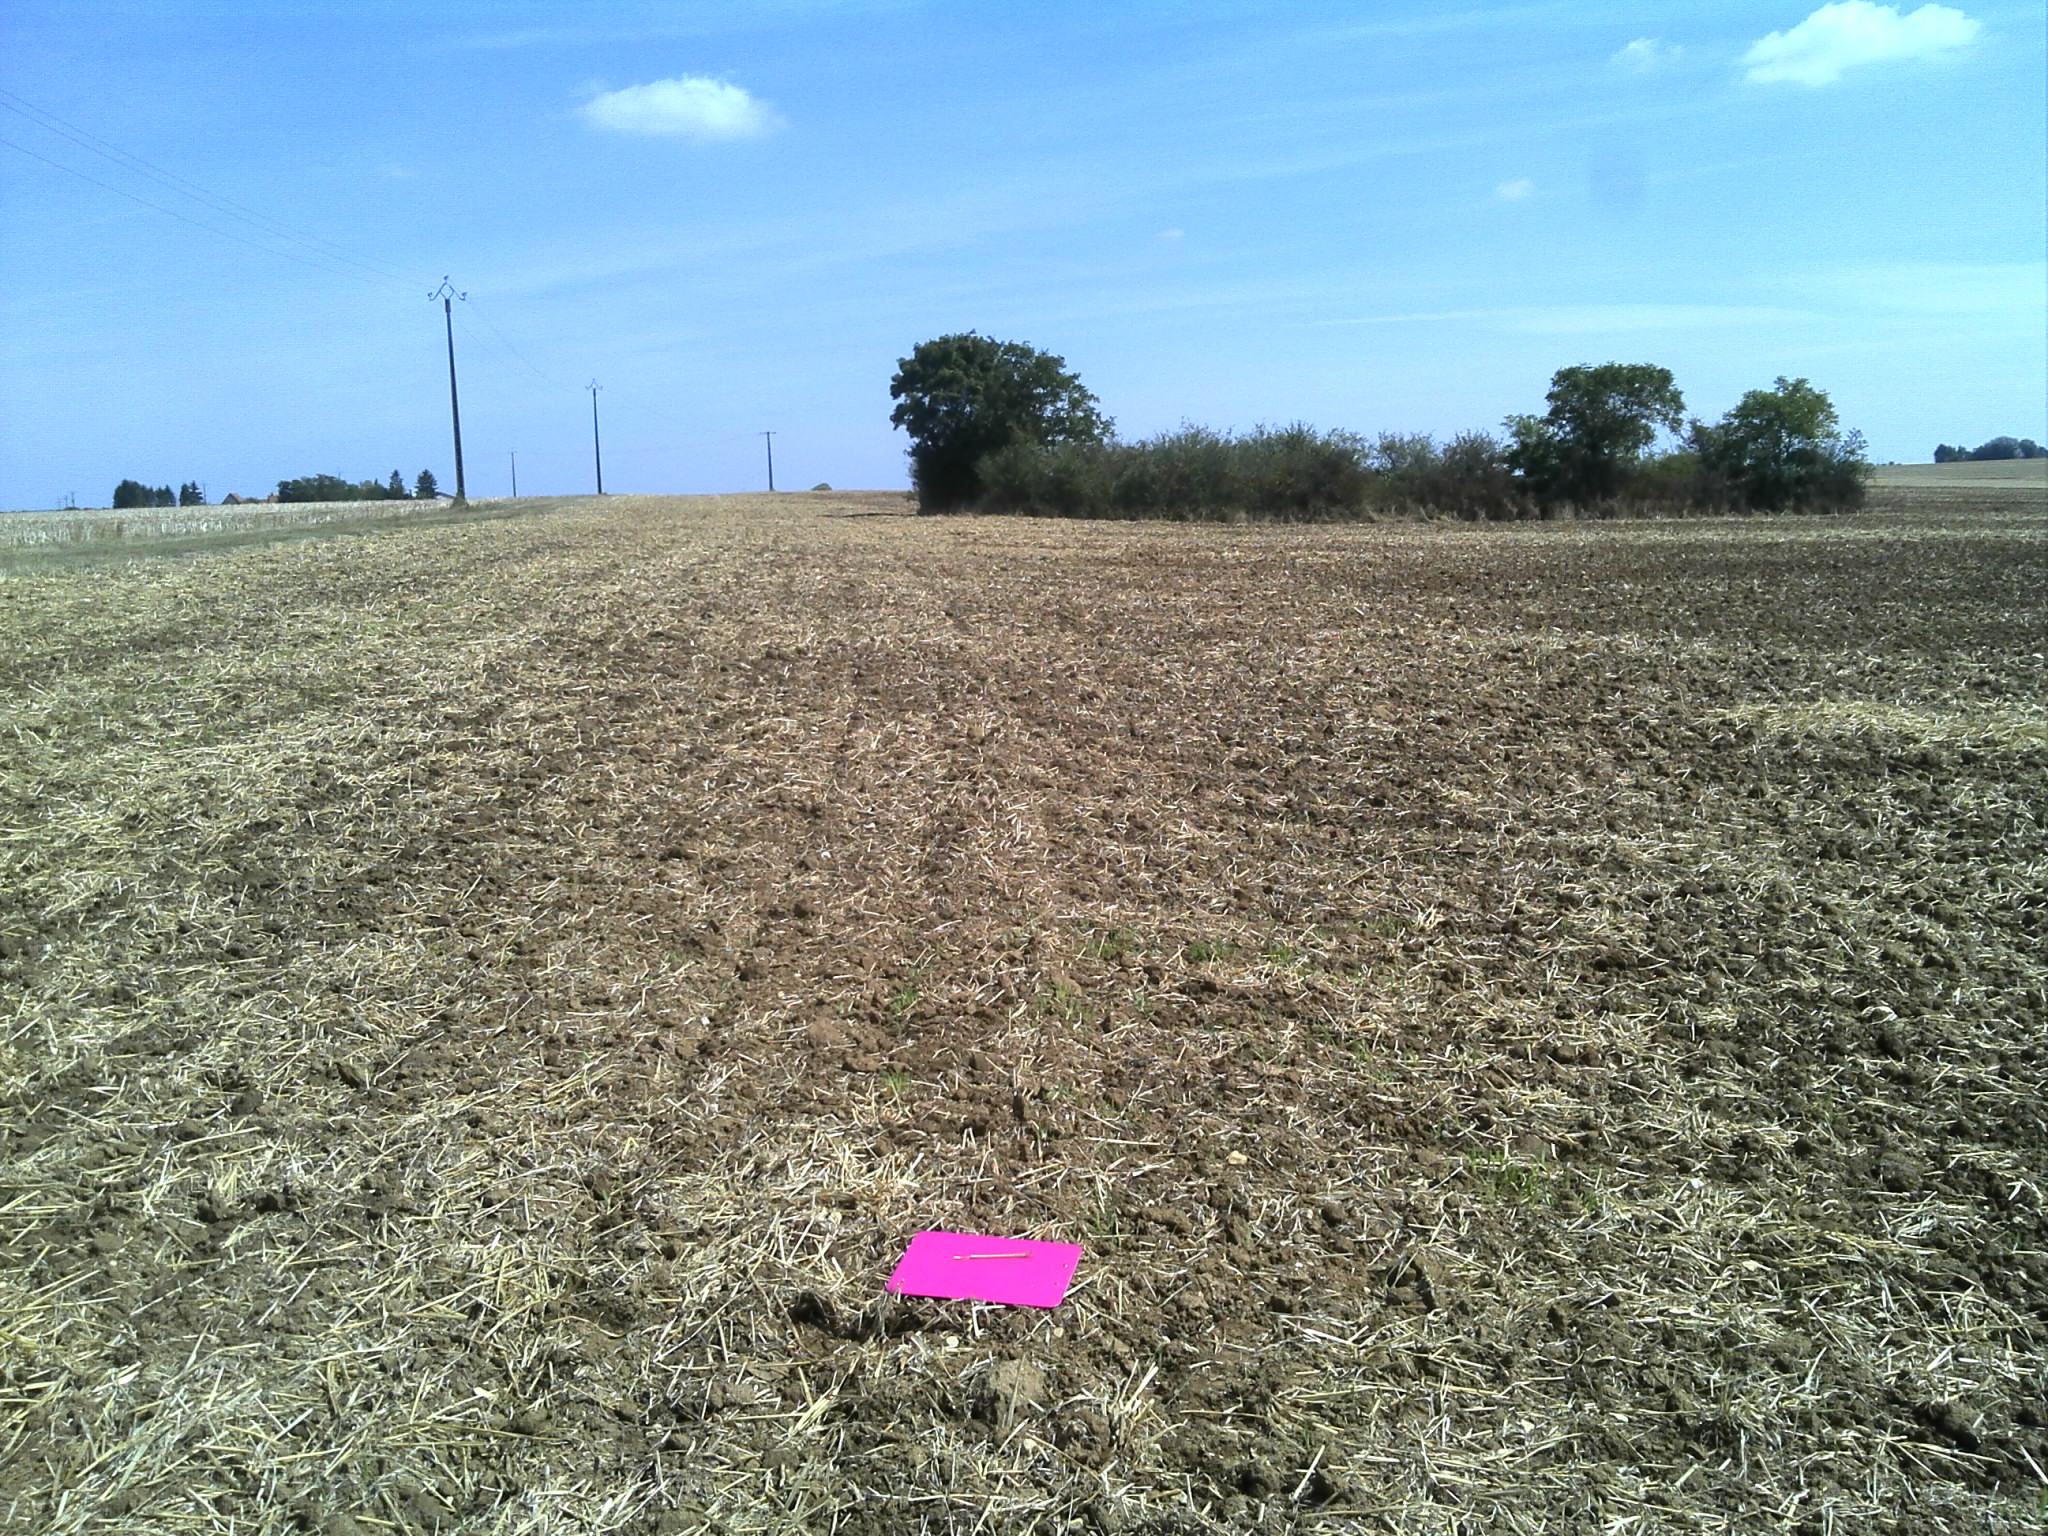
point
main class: Cropland
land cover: Barley
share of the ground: > 75 %
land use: Agriculture (excluding fallow land and kitchen gardens)
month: August
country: FR
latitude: 46.9548
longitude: 1.5128
